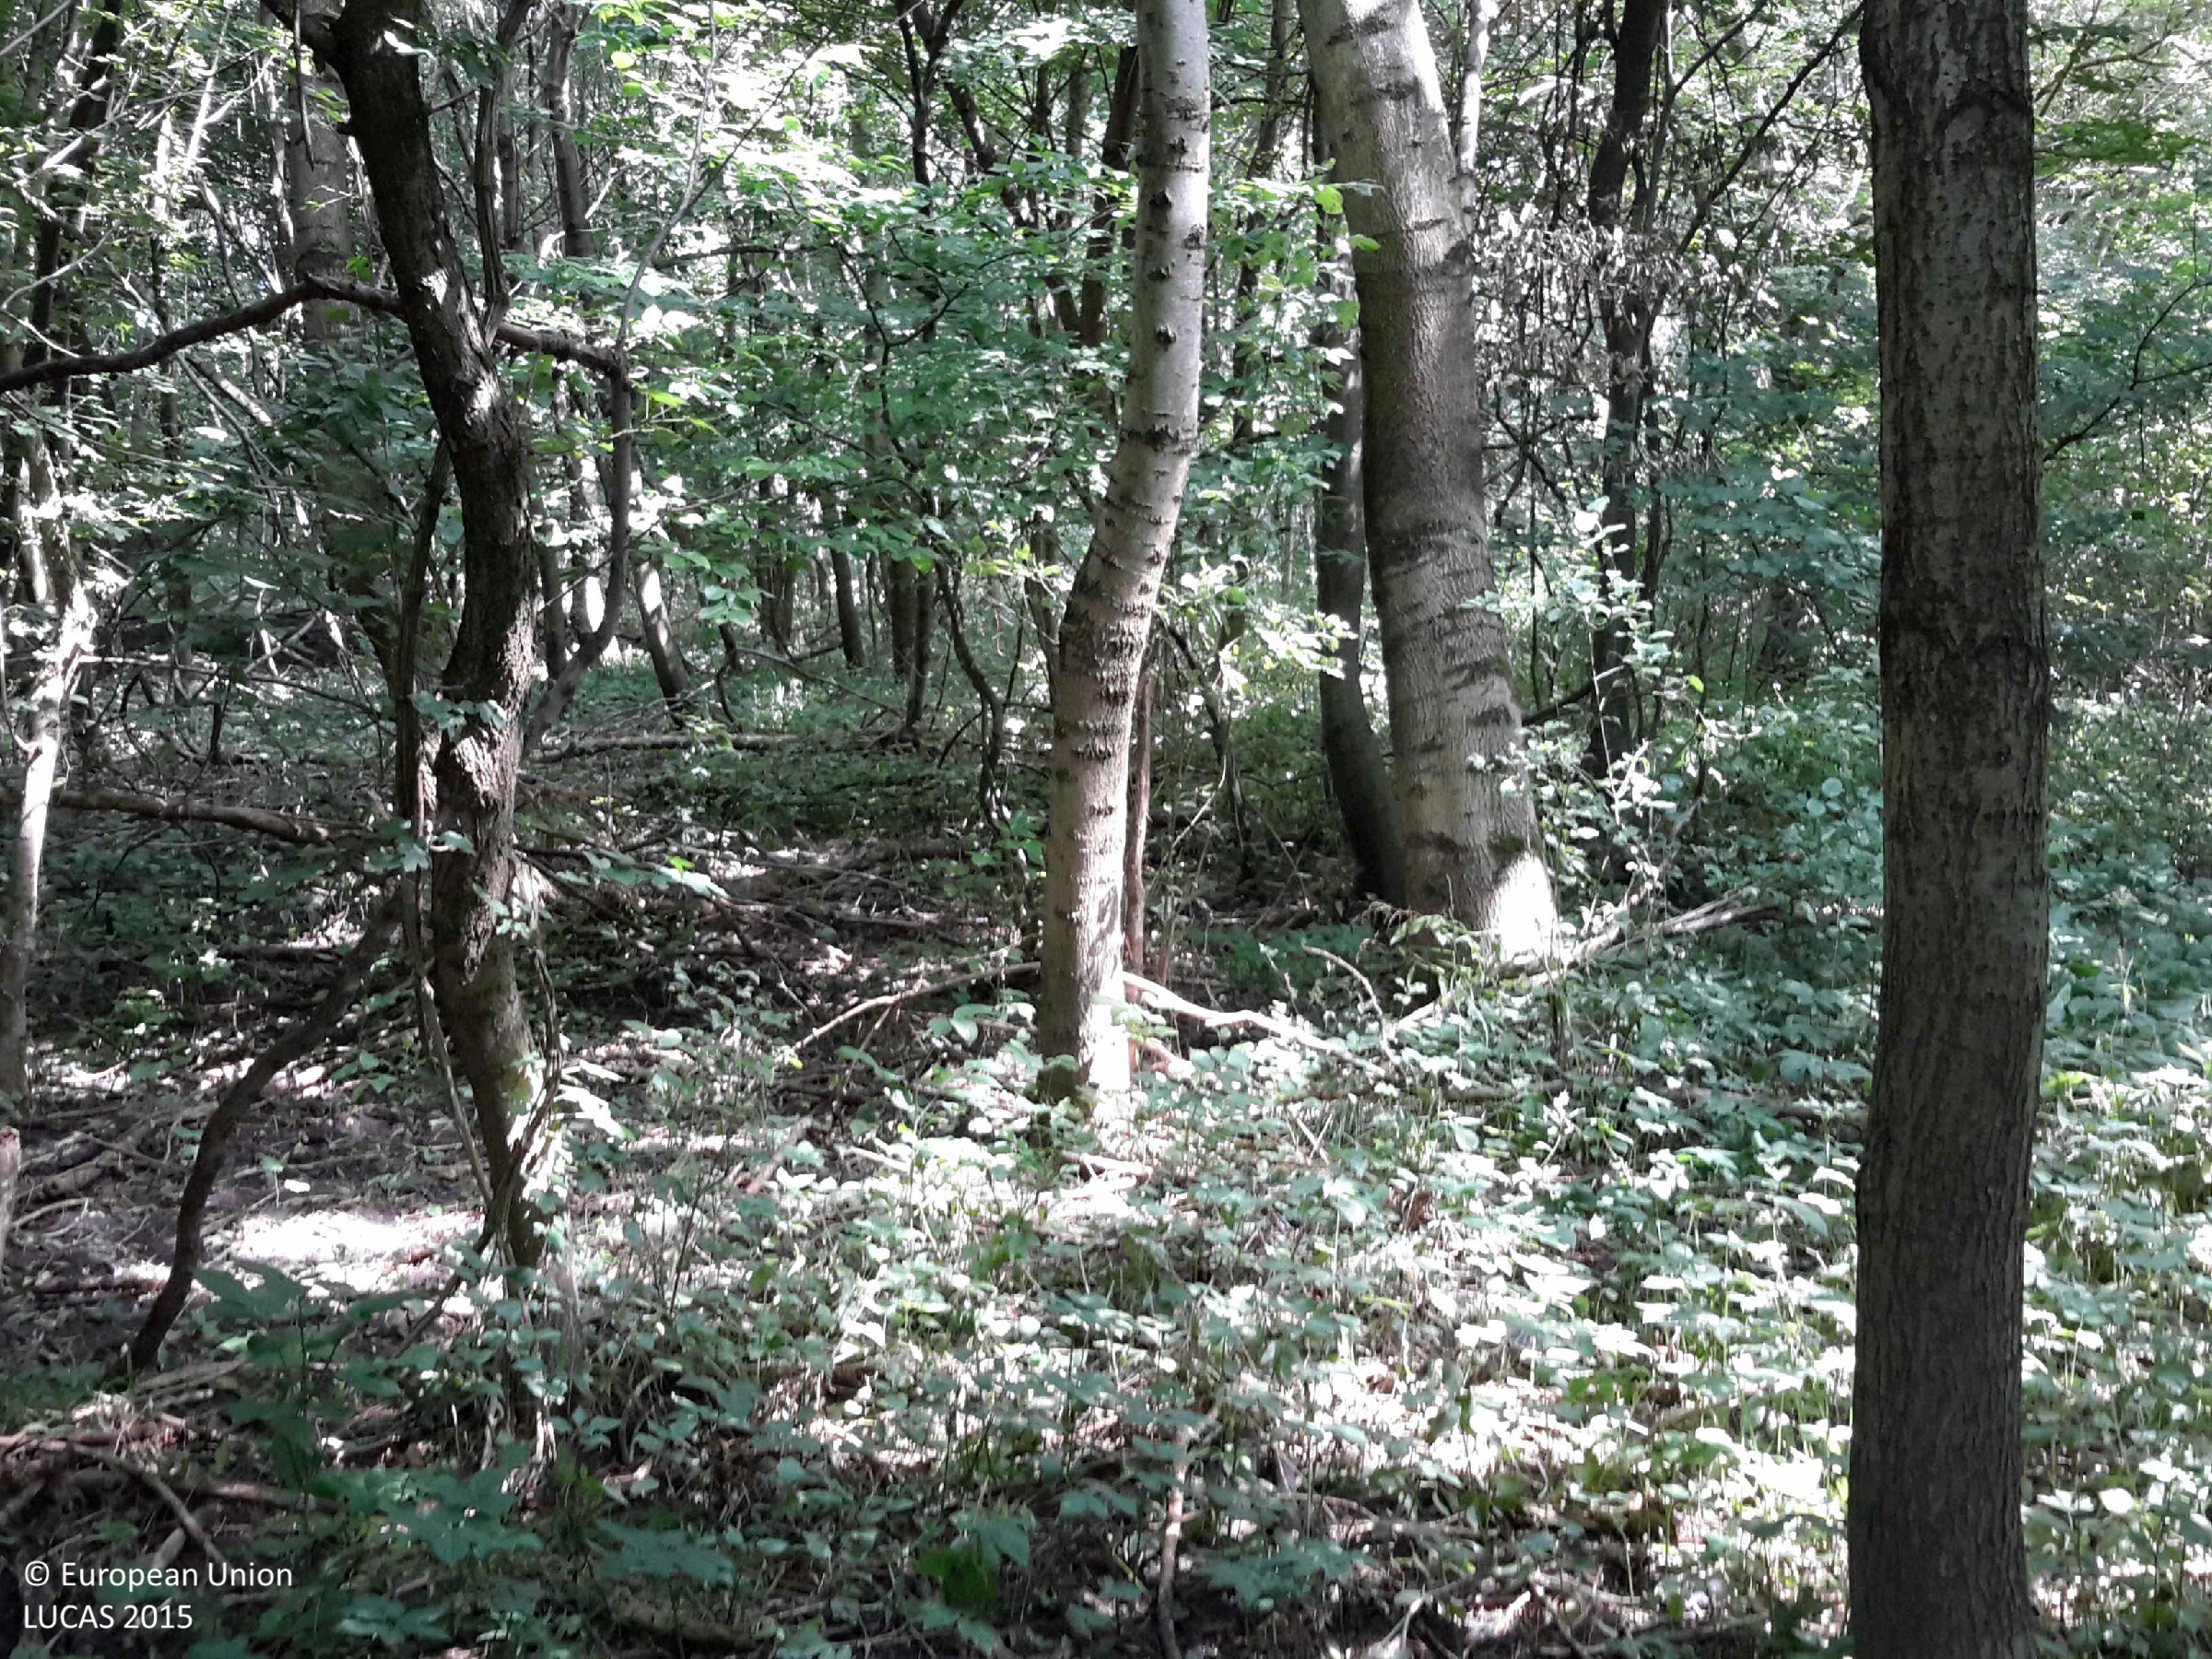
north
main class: Woodland
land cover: Broadleaved woodland
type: mesophytic deciduous forest
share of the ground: > 75 %
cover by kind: broadleaved forest trees 90 %, shrubs 5 %, herbaceous plants 5 %
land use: Forestry
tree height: > 5 m
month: July
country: HU
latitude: 47.4397
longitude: 17.0202
